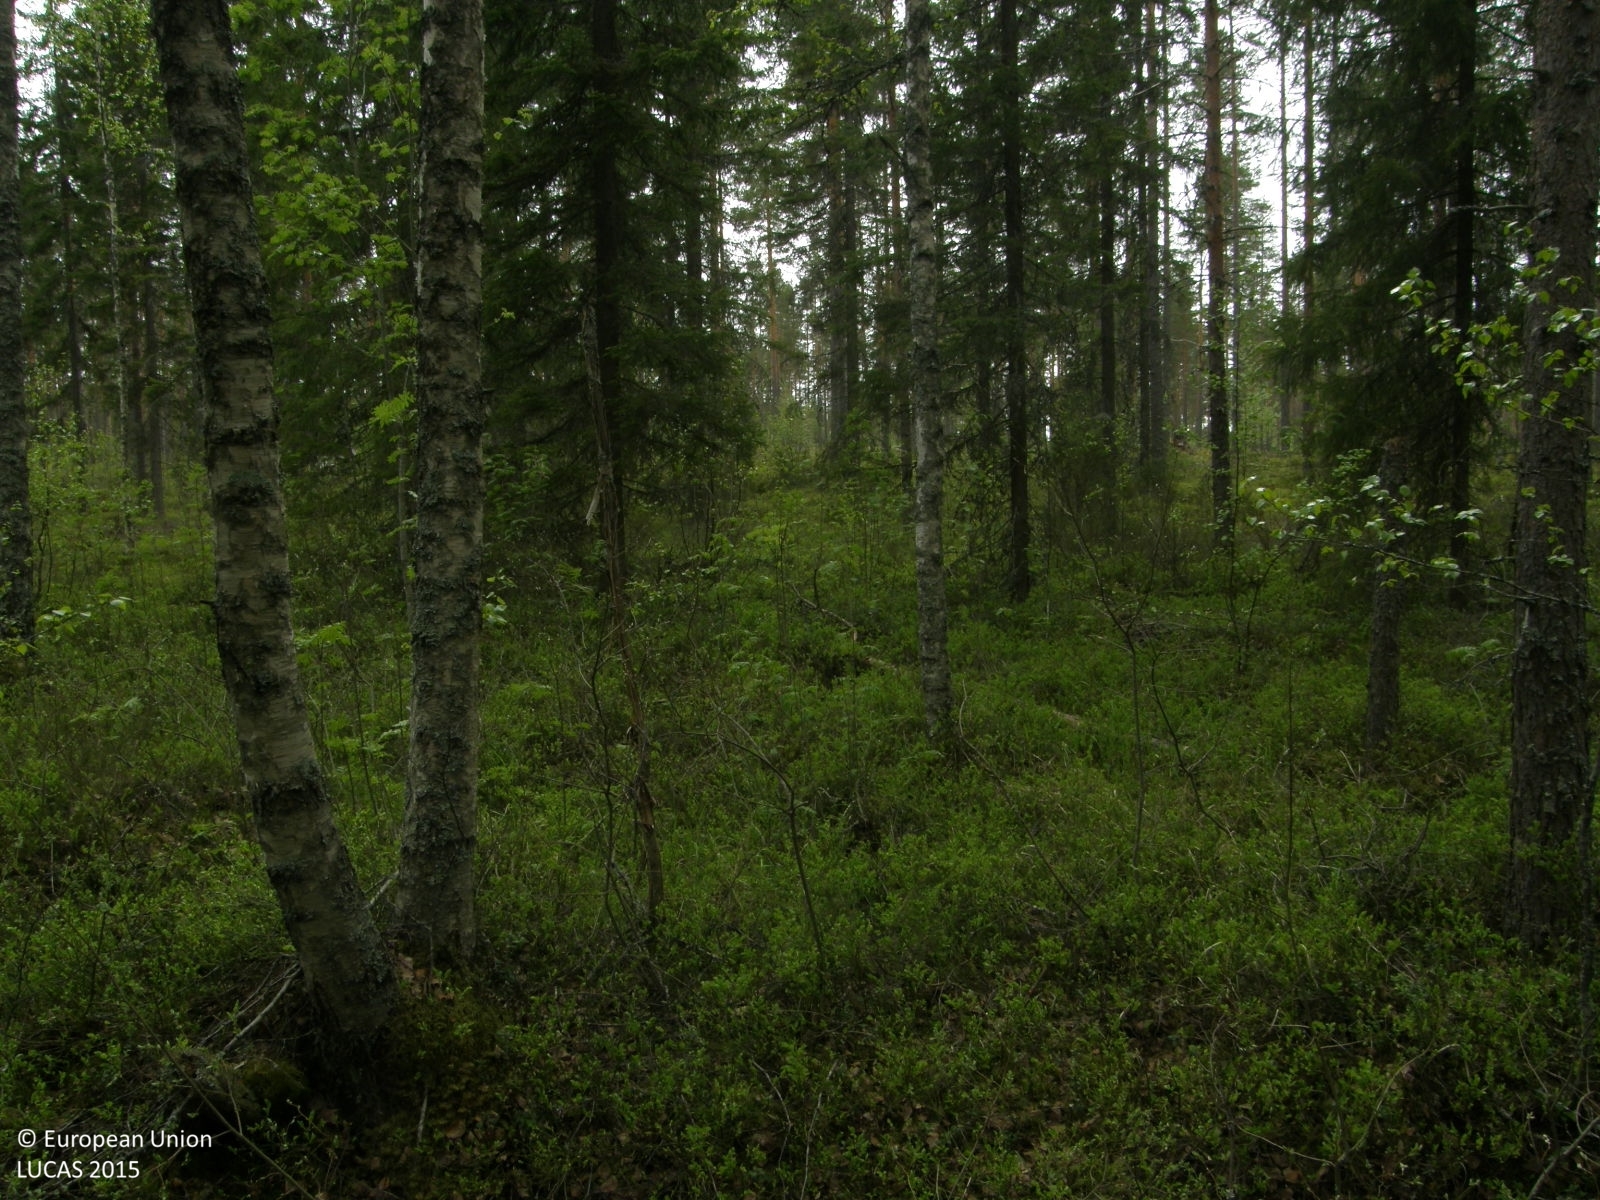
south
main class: Woodland
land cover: Pine dominated mixed woodland
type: boreal forest
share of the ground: > 75 %
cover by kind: coniferous forest trees 55 %, broadleaved forest trees 35 %, shrubs 10 %
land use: Forestry
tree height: > 5 m
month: June
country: FI
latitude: 62.0643
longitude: 22.3605
